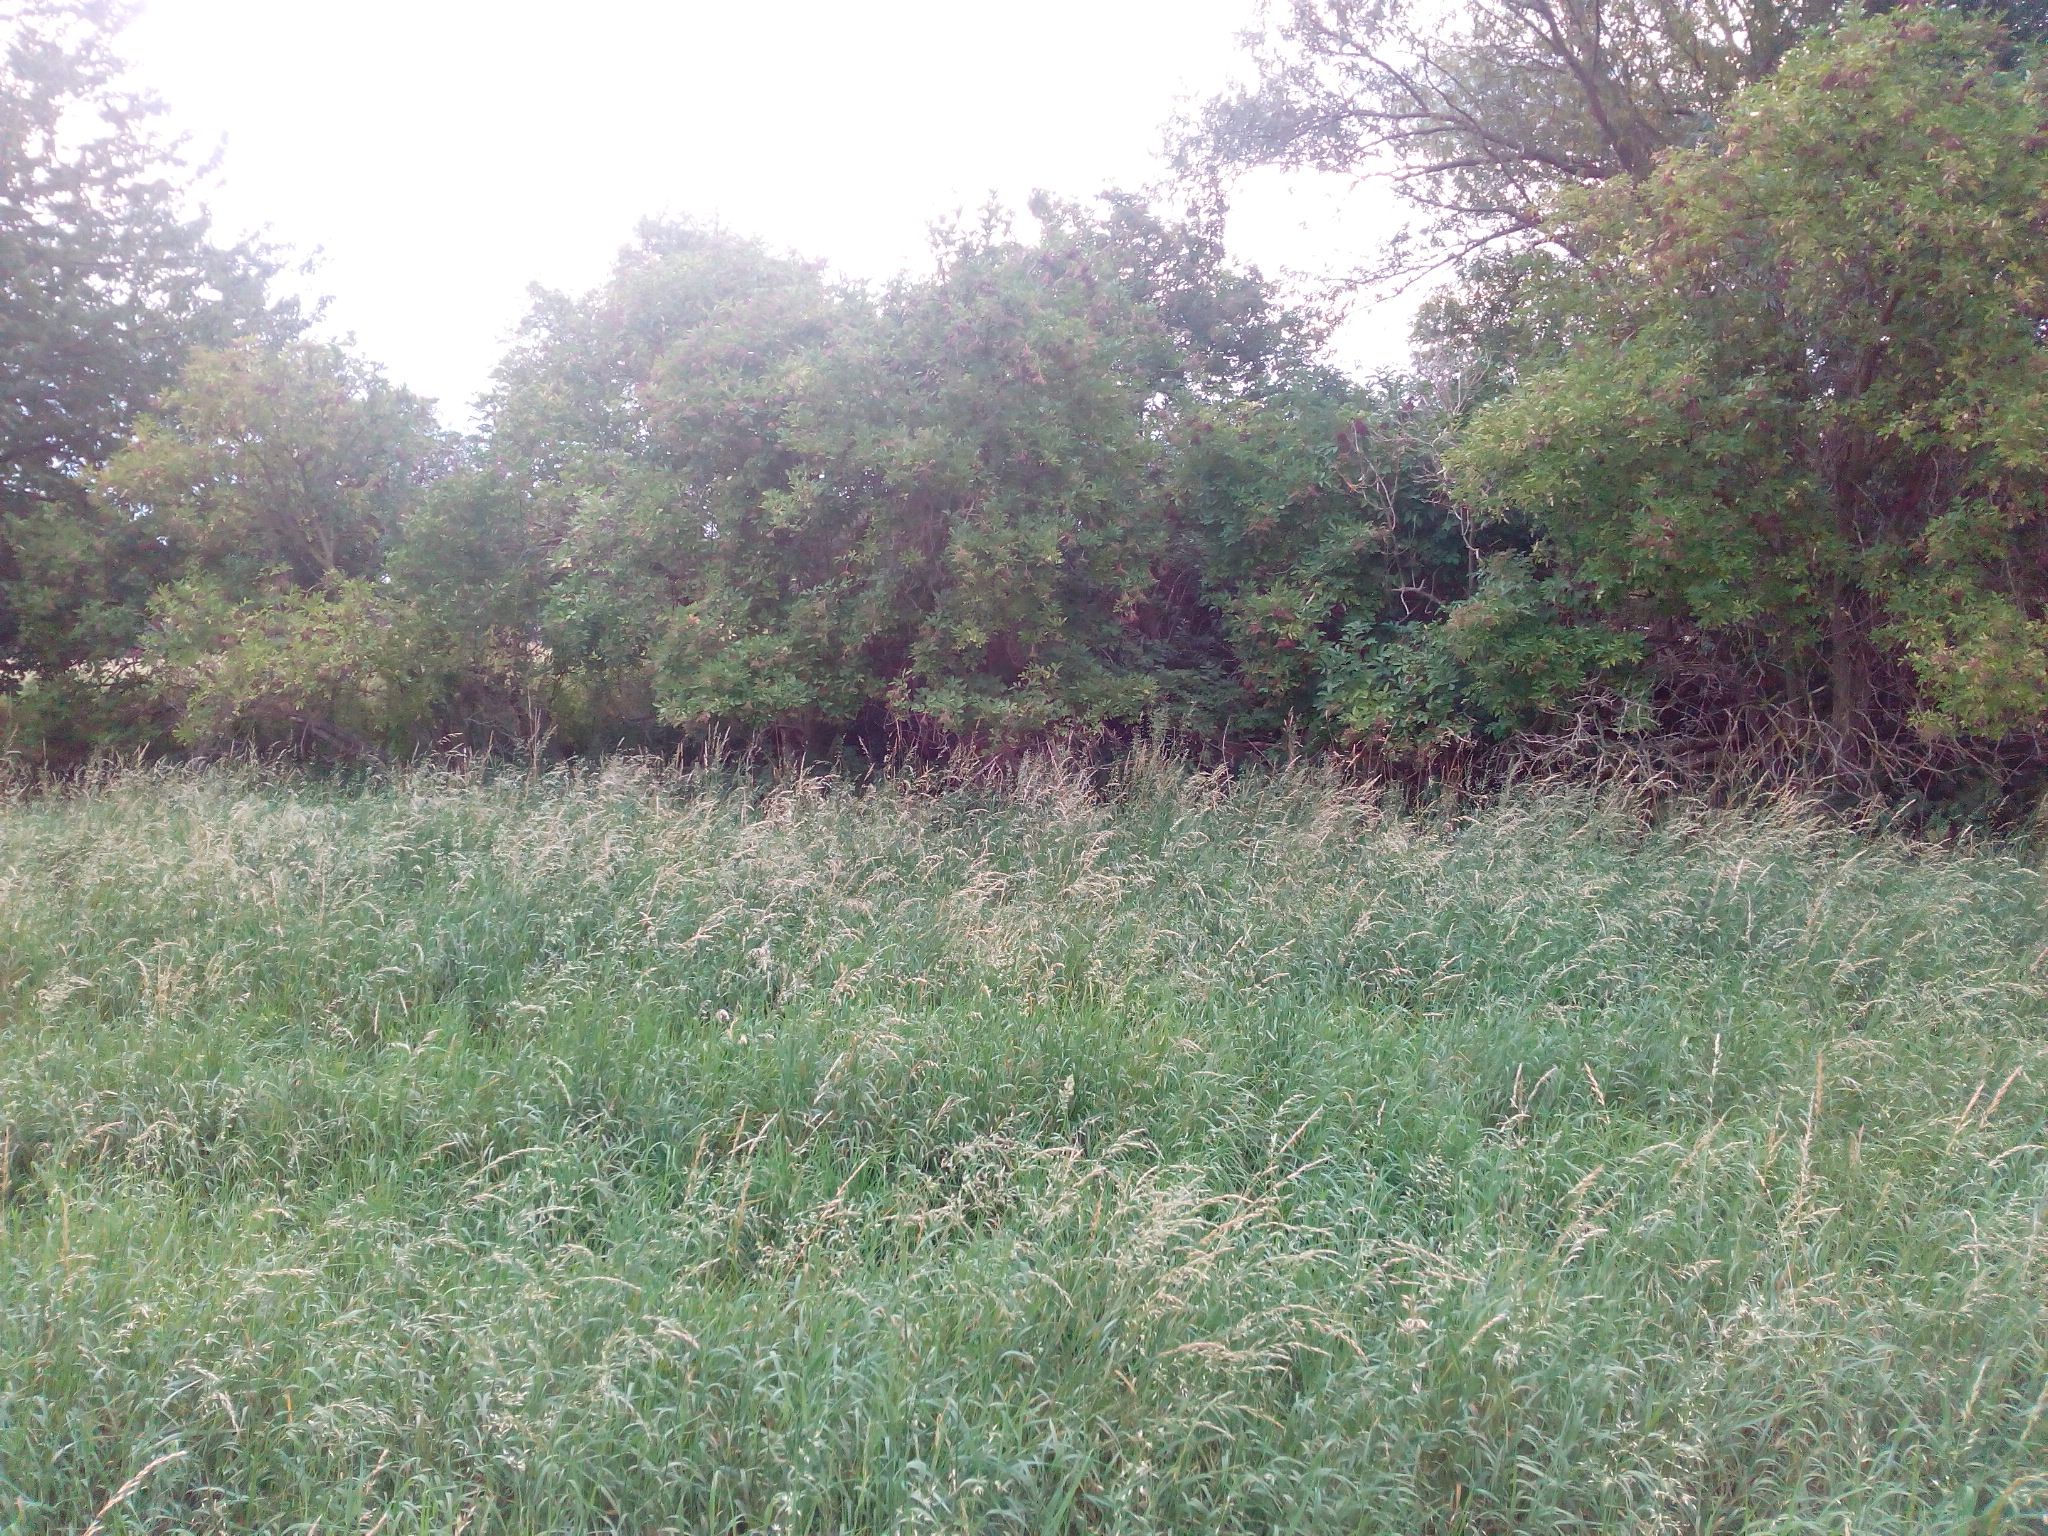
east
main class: Grassland
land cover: Grassland without tree/shrub cover
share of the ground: > 75 %
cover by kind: herbaceous plants 100 %
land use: Agriculture (excluding fallow land and kitchen gardens)
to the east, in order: Grassland without tree/shrub cover; Broadleaved woodland; Ditches and canals; Grassland without tree/shrub cover; Shrubland with sparse tree cover; Railways; Grassland without tree/shrub cover; Broadleaved woodland; Artificial constructions in urban areas
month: August
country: DE
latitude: 52.1617
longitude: 9.9269
